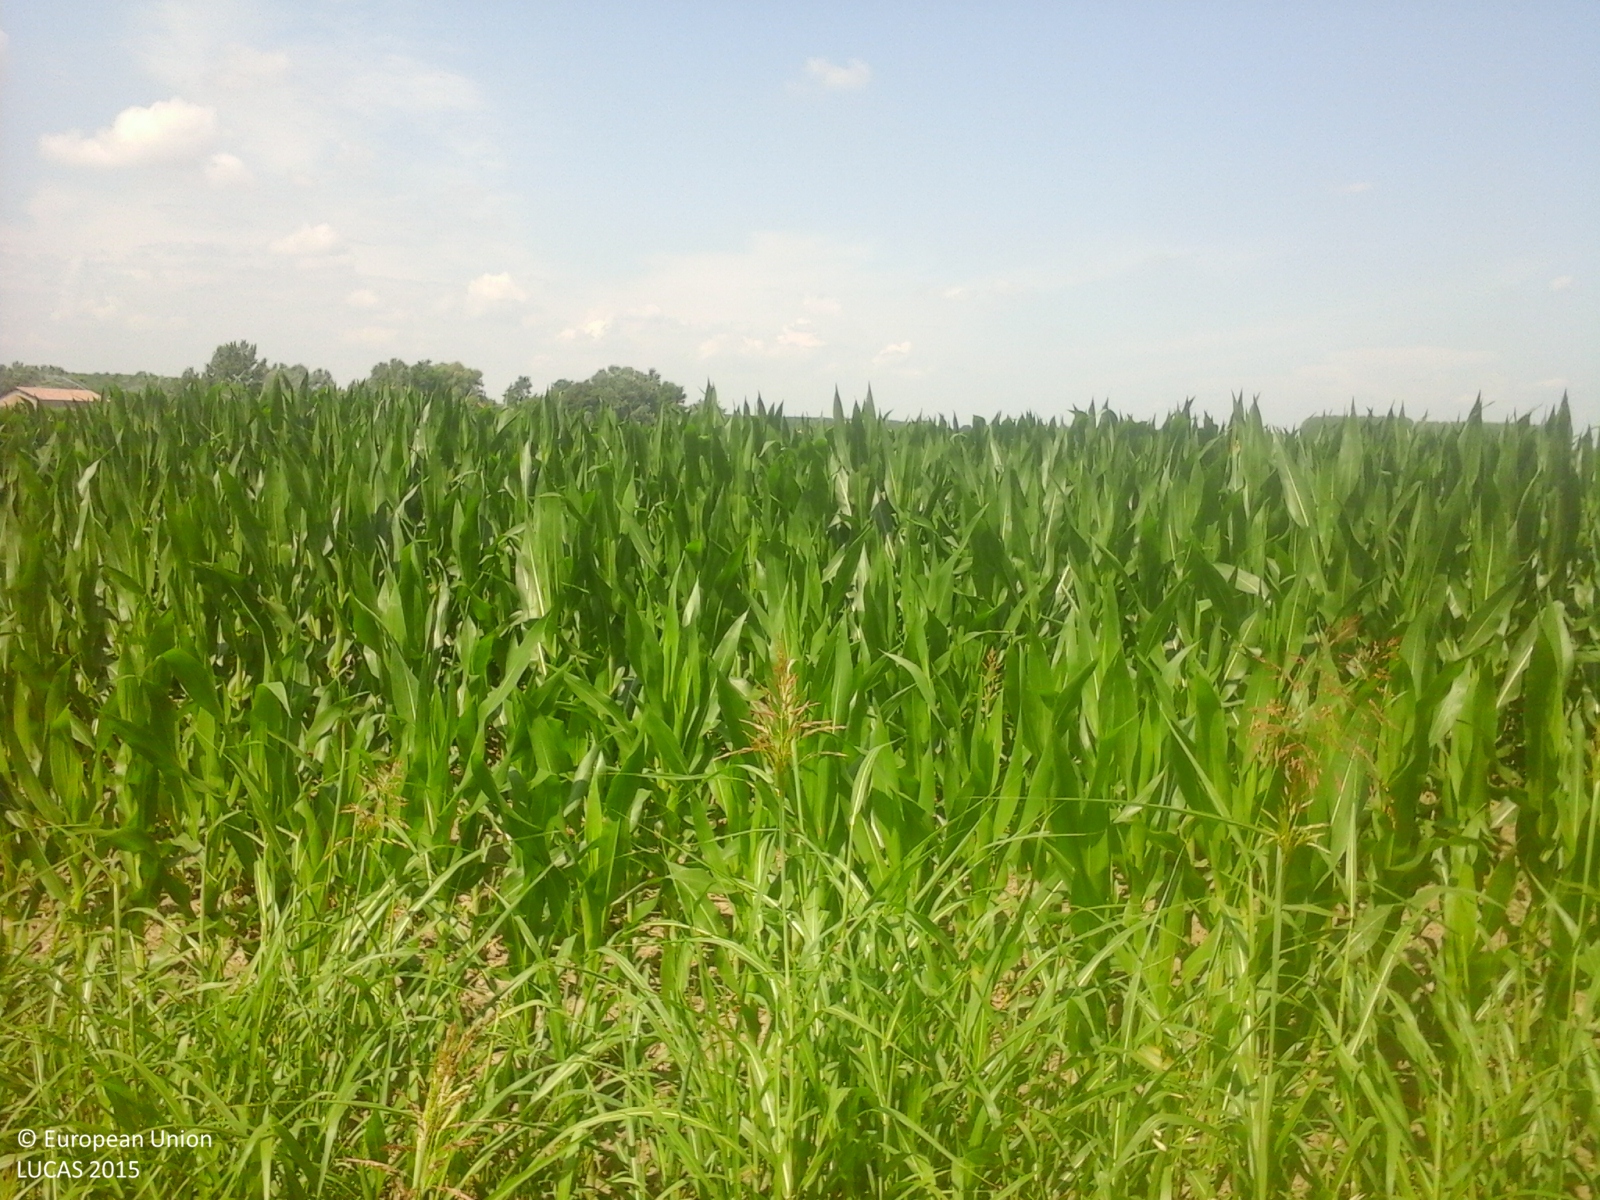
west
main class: Cropland
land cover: Maize
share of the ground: > 75 %
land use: Agriculture (excluding fallow land and kitchen gardens)
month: June
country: IT
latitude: 44.8329
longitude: 10.9720
